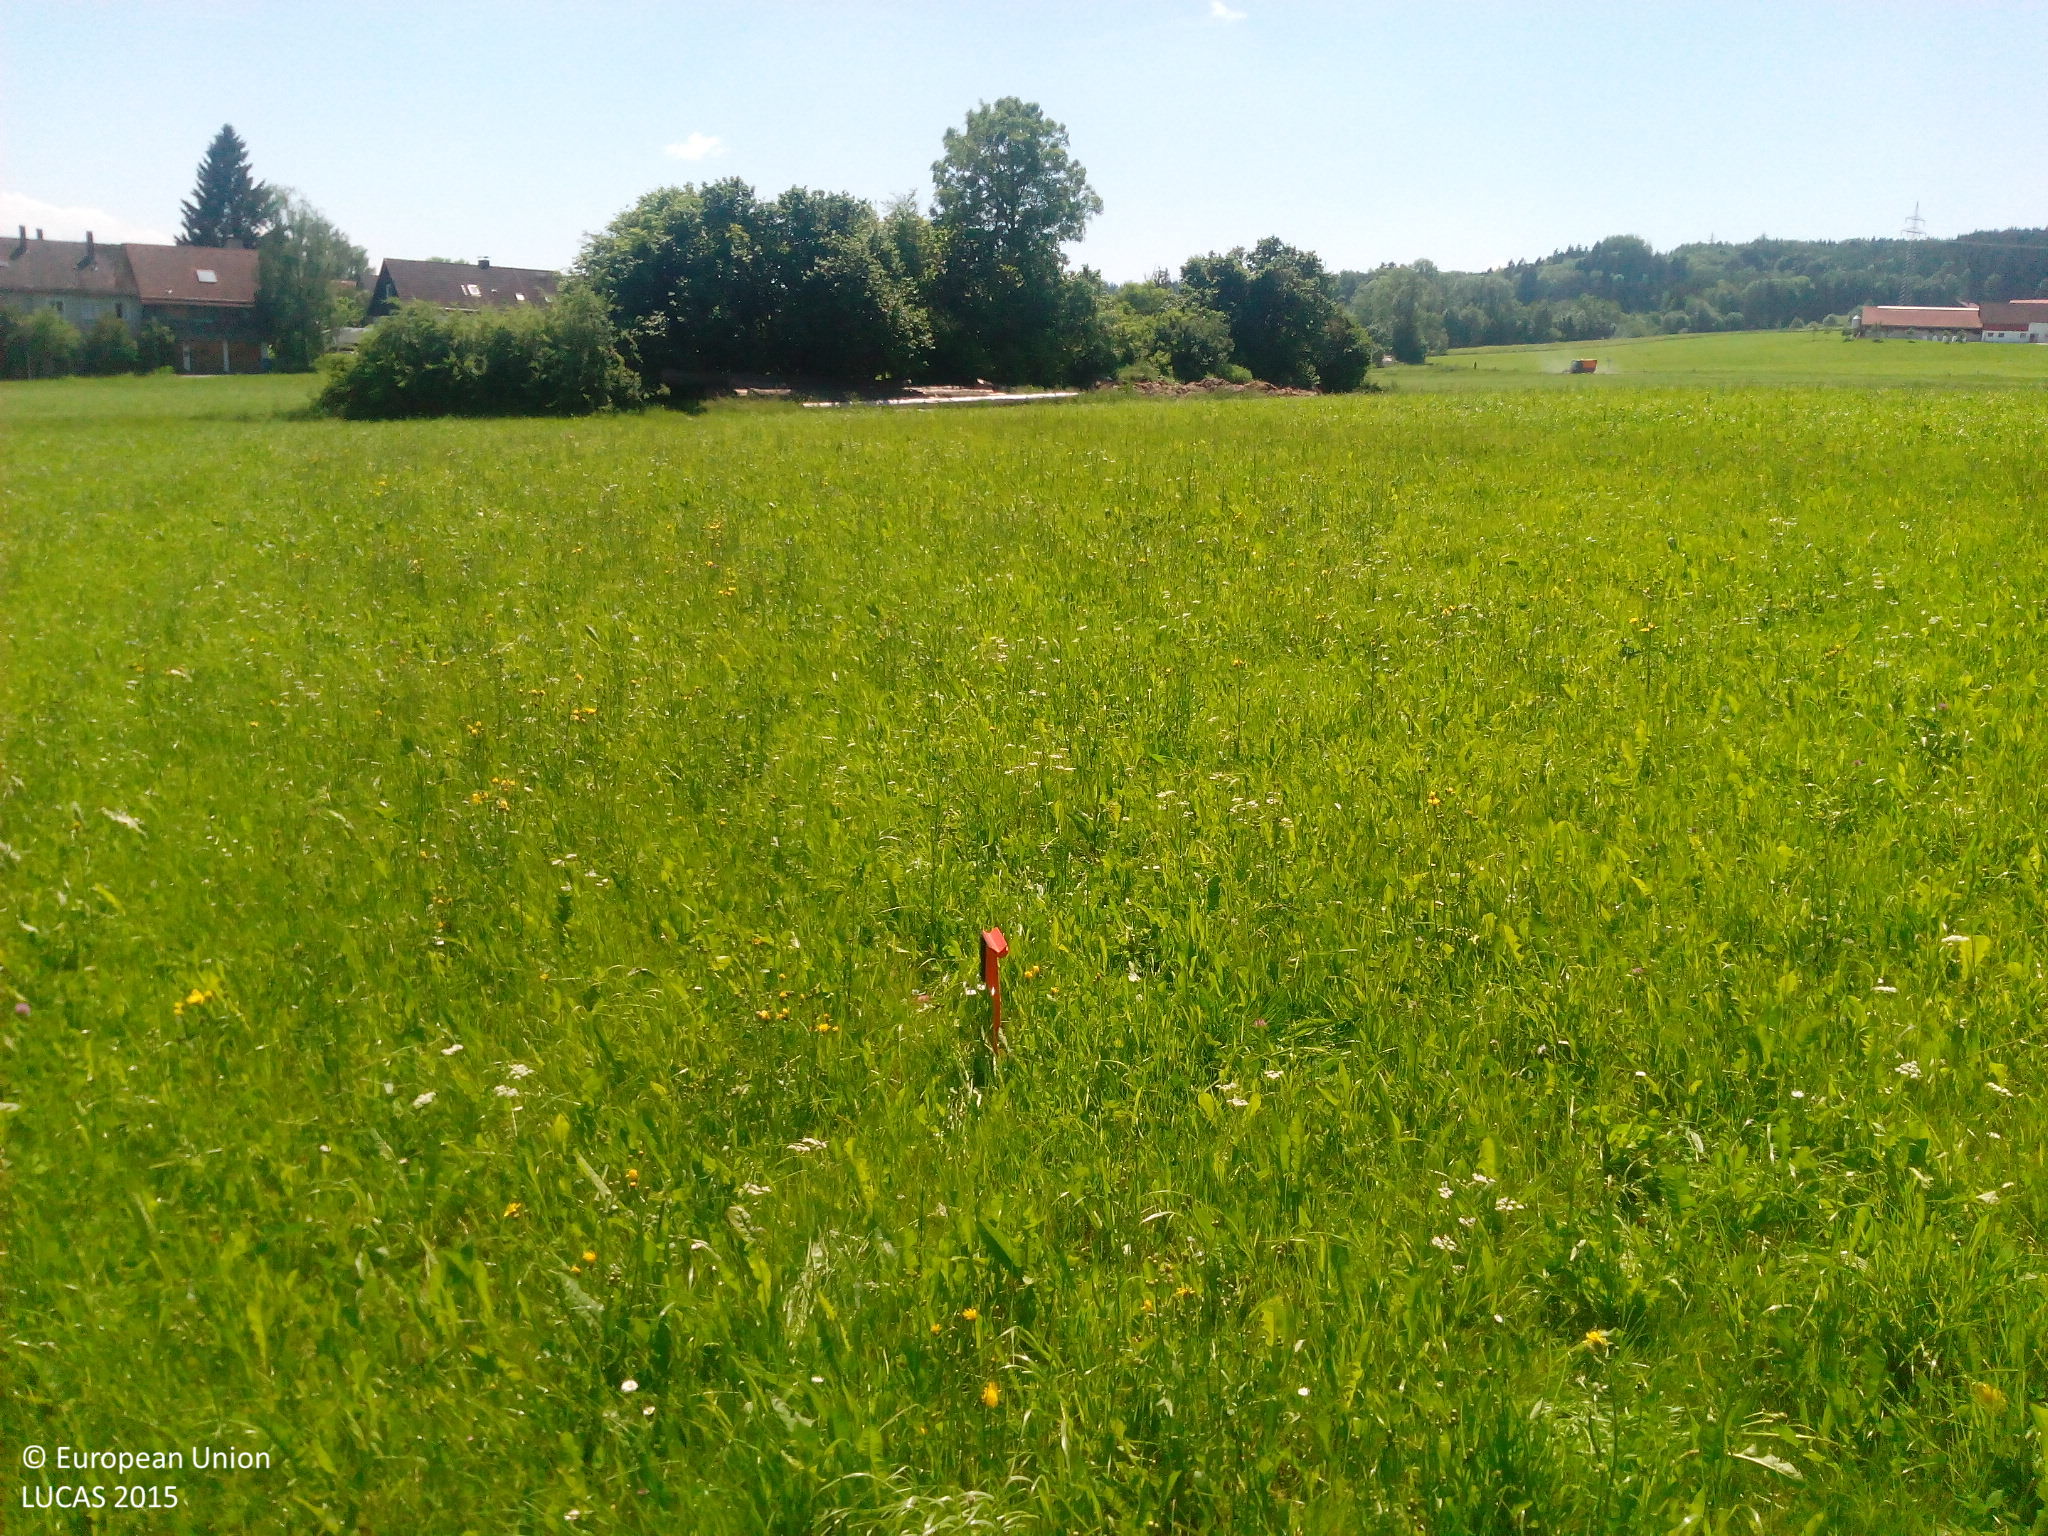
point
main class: Grassland
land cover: Grassland without tree/shrub cover
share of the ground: > 75 %
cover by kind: herbaceous plants 100 %
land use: Agriculture (excluding fallow land and kitchen gardens)
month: June
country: DE
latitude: 47.8620
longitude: 10.6011
